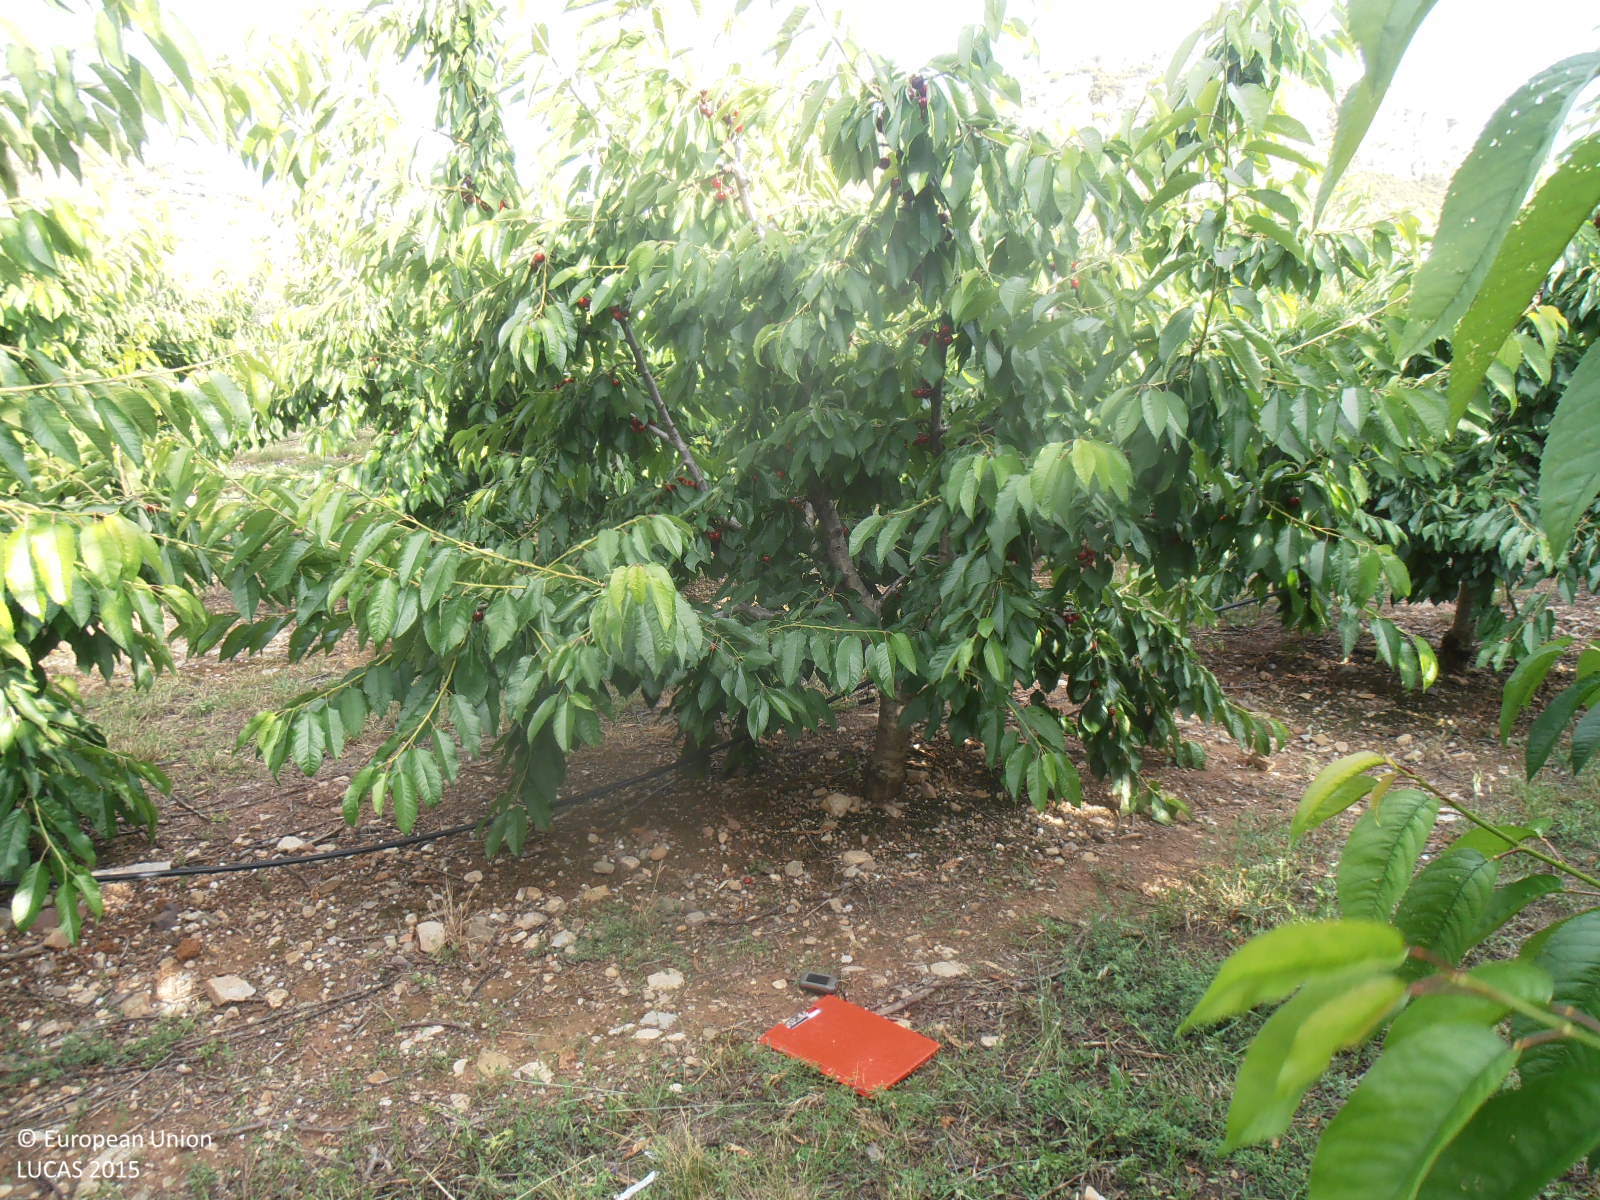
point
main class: Cropland
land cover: Cherry fruit
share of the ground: > 75 %
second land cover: Spontaneously vegetated surfaces
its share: 10 - 25 %
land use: Agriculture (excluding fallow land and kitchen gardens)
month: June
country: ES
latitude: 41.4781
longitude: -1.4131
